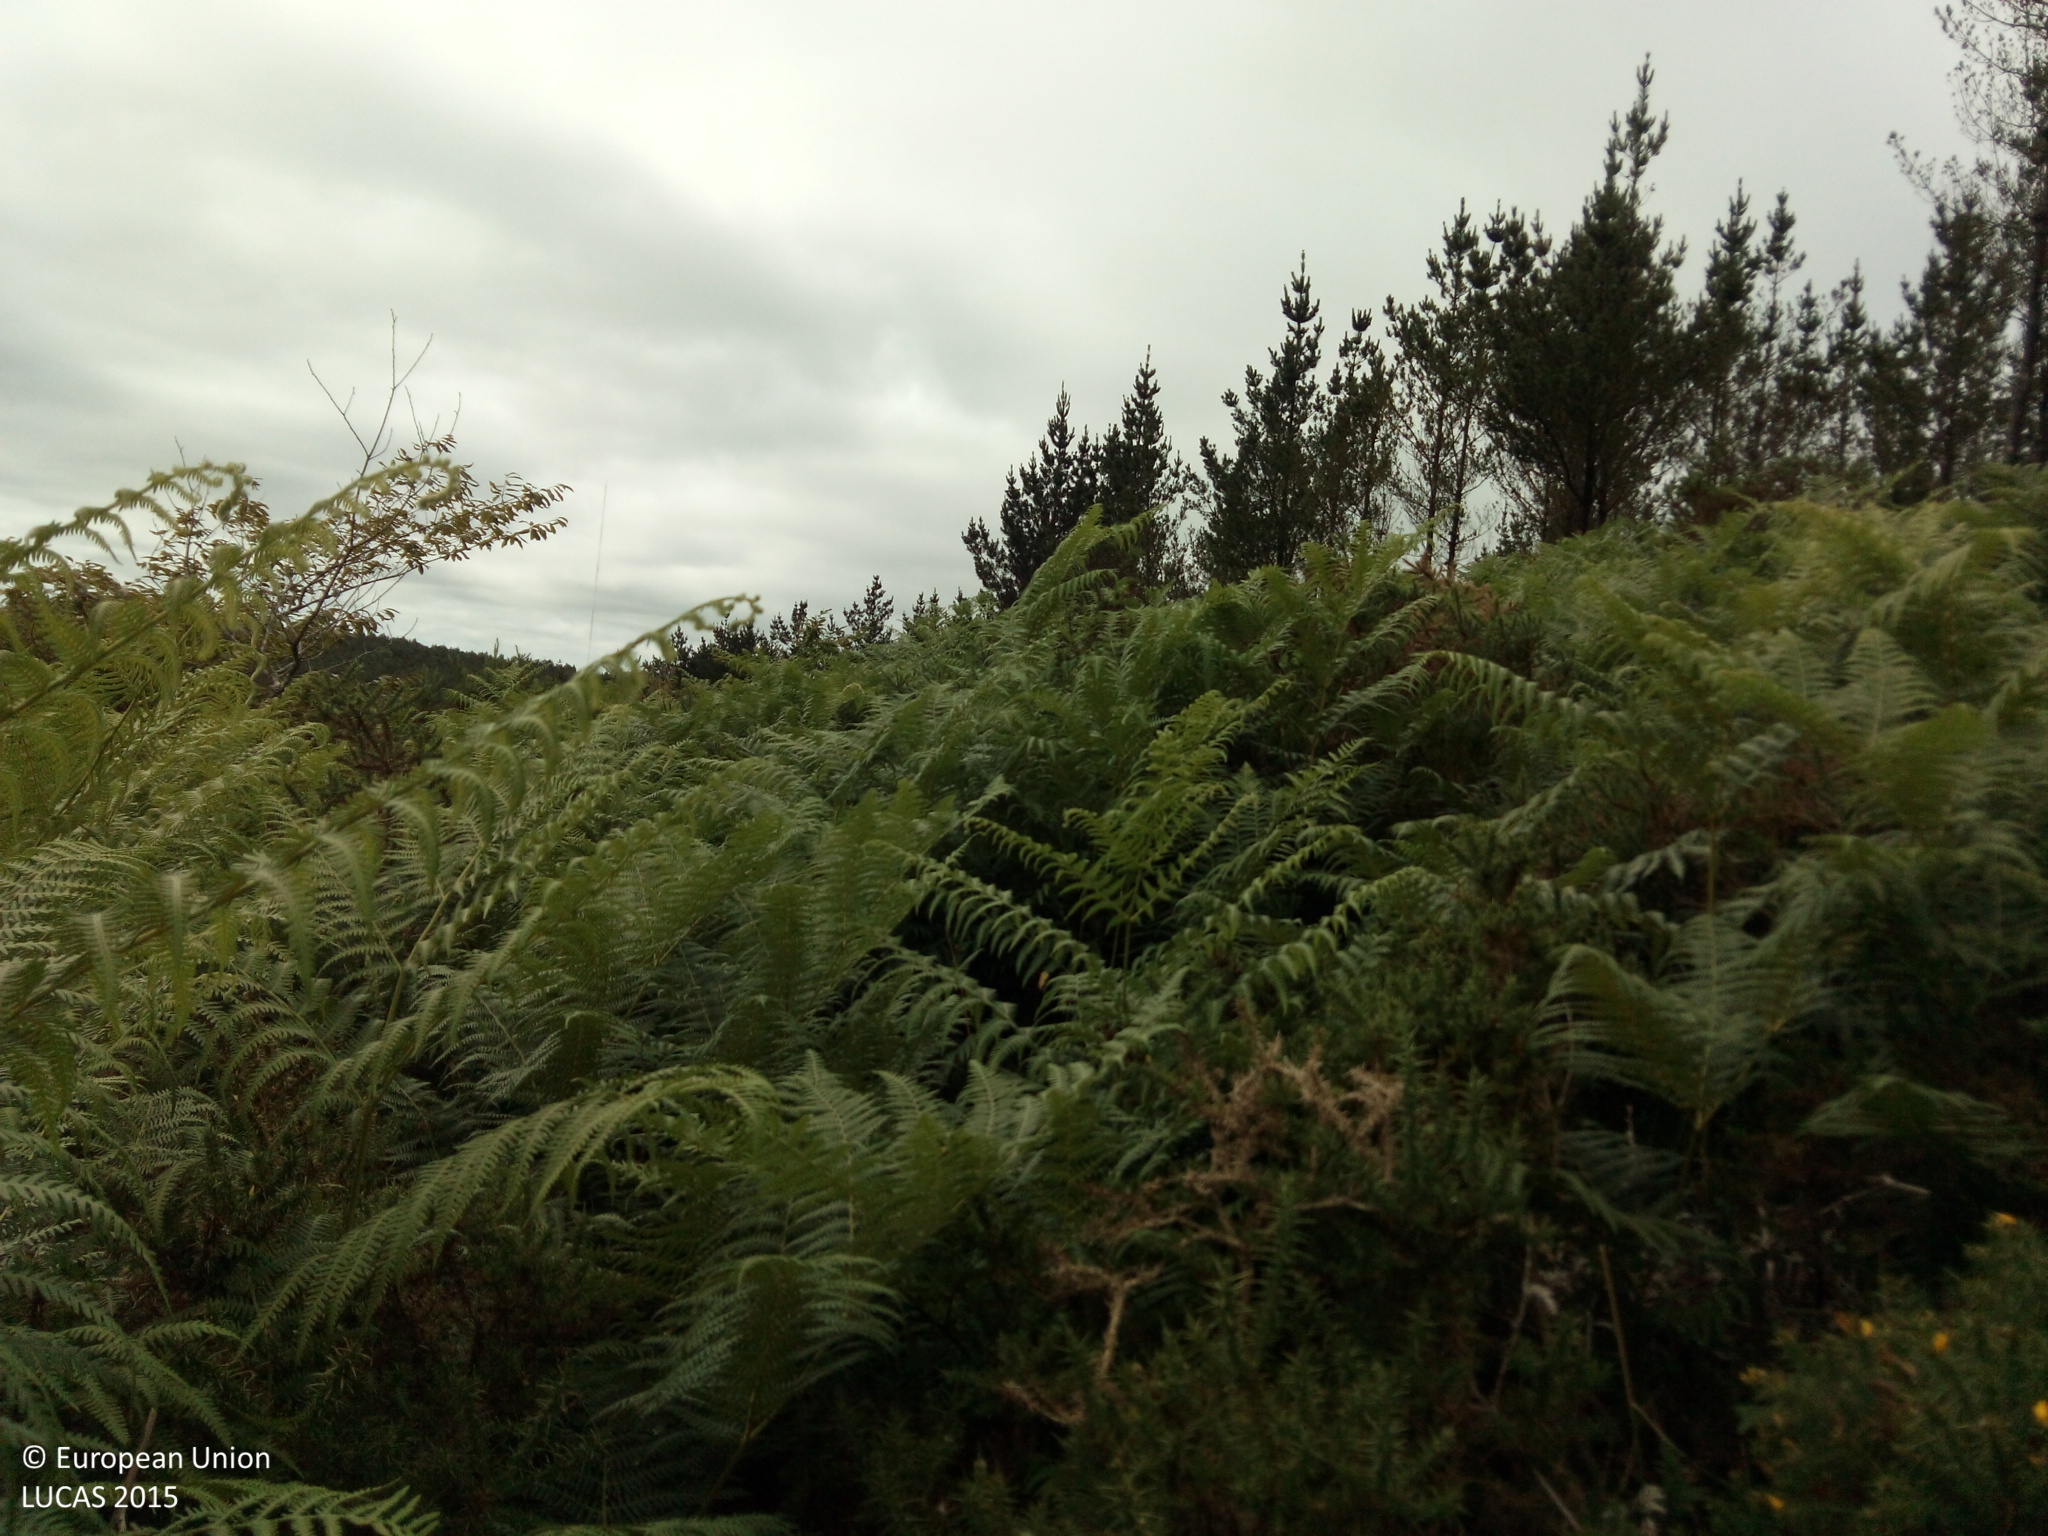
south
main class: Woodland
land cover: Spruce dominated coniferous woodland
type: exotic forest
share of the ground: > 75 %
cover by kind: shrubs 70 %, coniferous forest trees 30 %
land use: Forestry
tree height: < 5 m
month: July
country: ES
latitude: 42.5797
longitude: -8.3839
